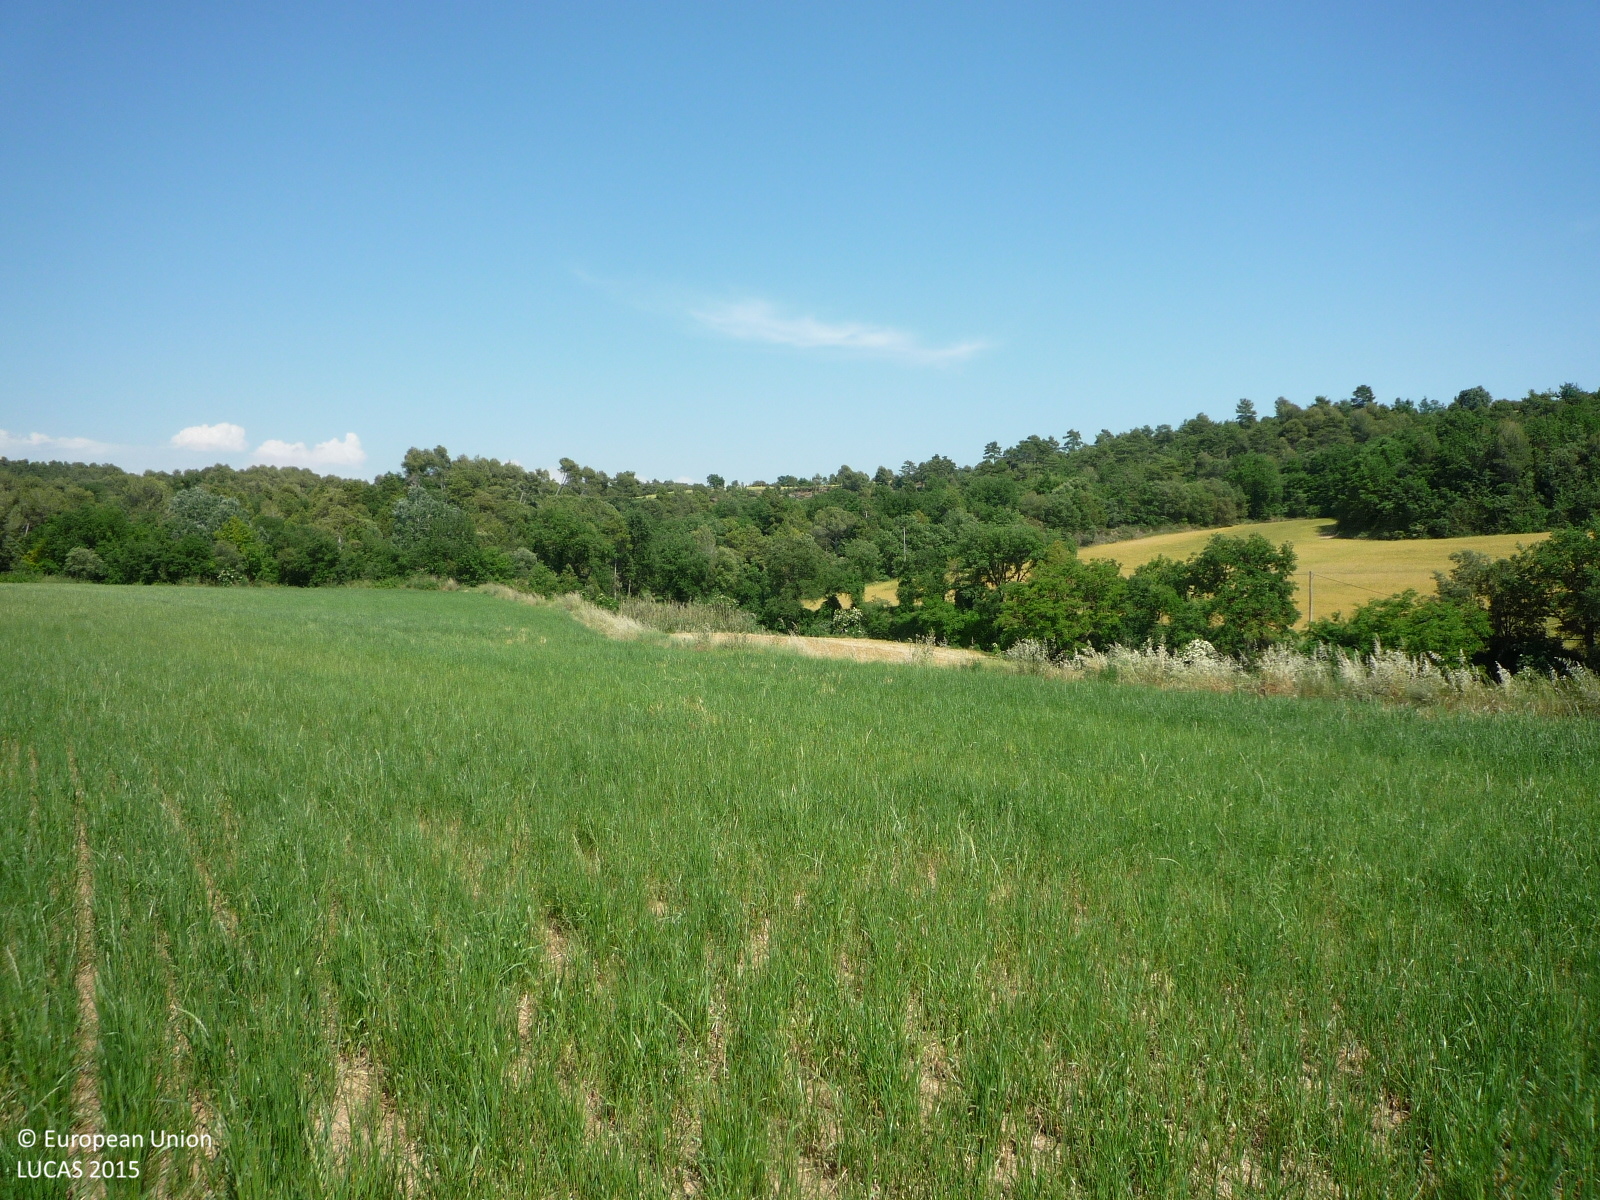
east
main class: Cropland
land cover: Temporary grasslands
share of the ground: > 75 %
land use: Agriculture (excluding fallow land and kitchen gardens)
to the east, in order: Temporary grasslands; Grassland without tree/shrub cover; Barley; Grassland without tree/shrub cover; Barley; Broadleaved woodland; Common wheat; Broadleaved woodland; Electric lines; Broadleaved woodland
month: May
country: ES
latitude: 41.8978
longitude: 1.9506
